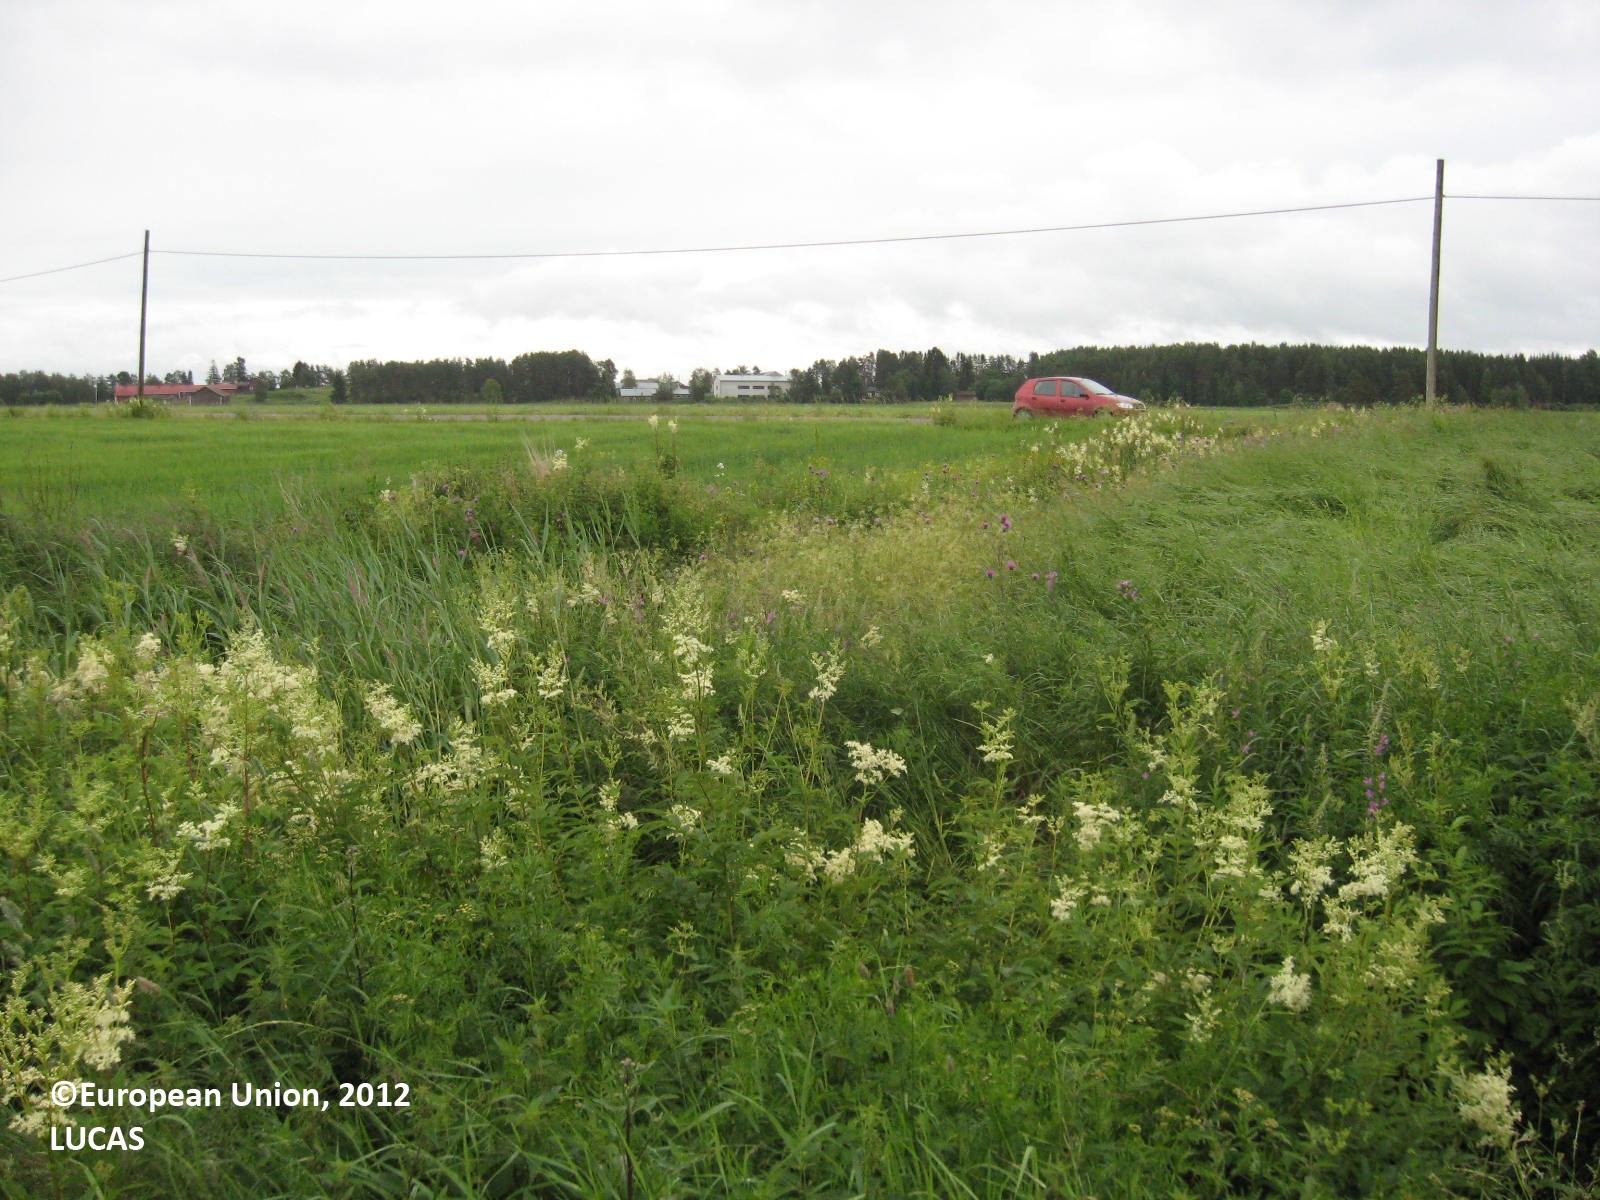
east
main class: Cropland
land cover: Barley
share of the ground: > 75 %
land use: Agriculture (excluding fallow land and kitchen gardens)
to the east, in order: Barley; Shruby margins; Ditches and canals; Shruby margins; Barley; Shruby margins; Ditches and canals; Grass margins; Paved roads, cycling and walking lanes; Grass margins; Electric lines; Grass margins
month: July
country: FI
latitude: 62.4652
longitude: 21.6992
